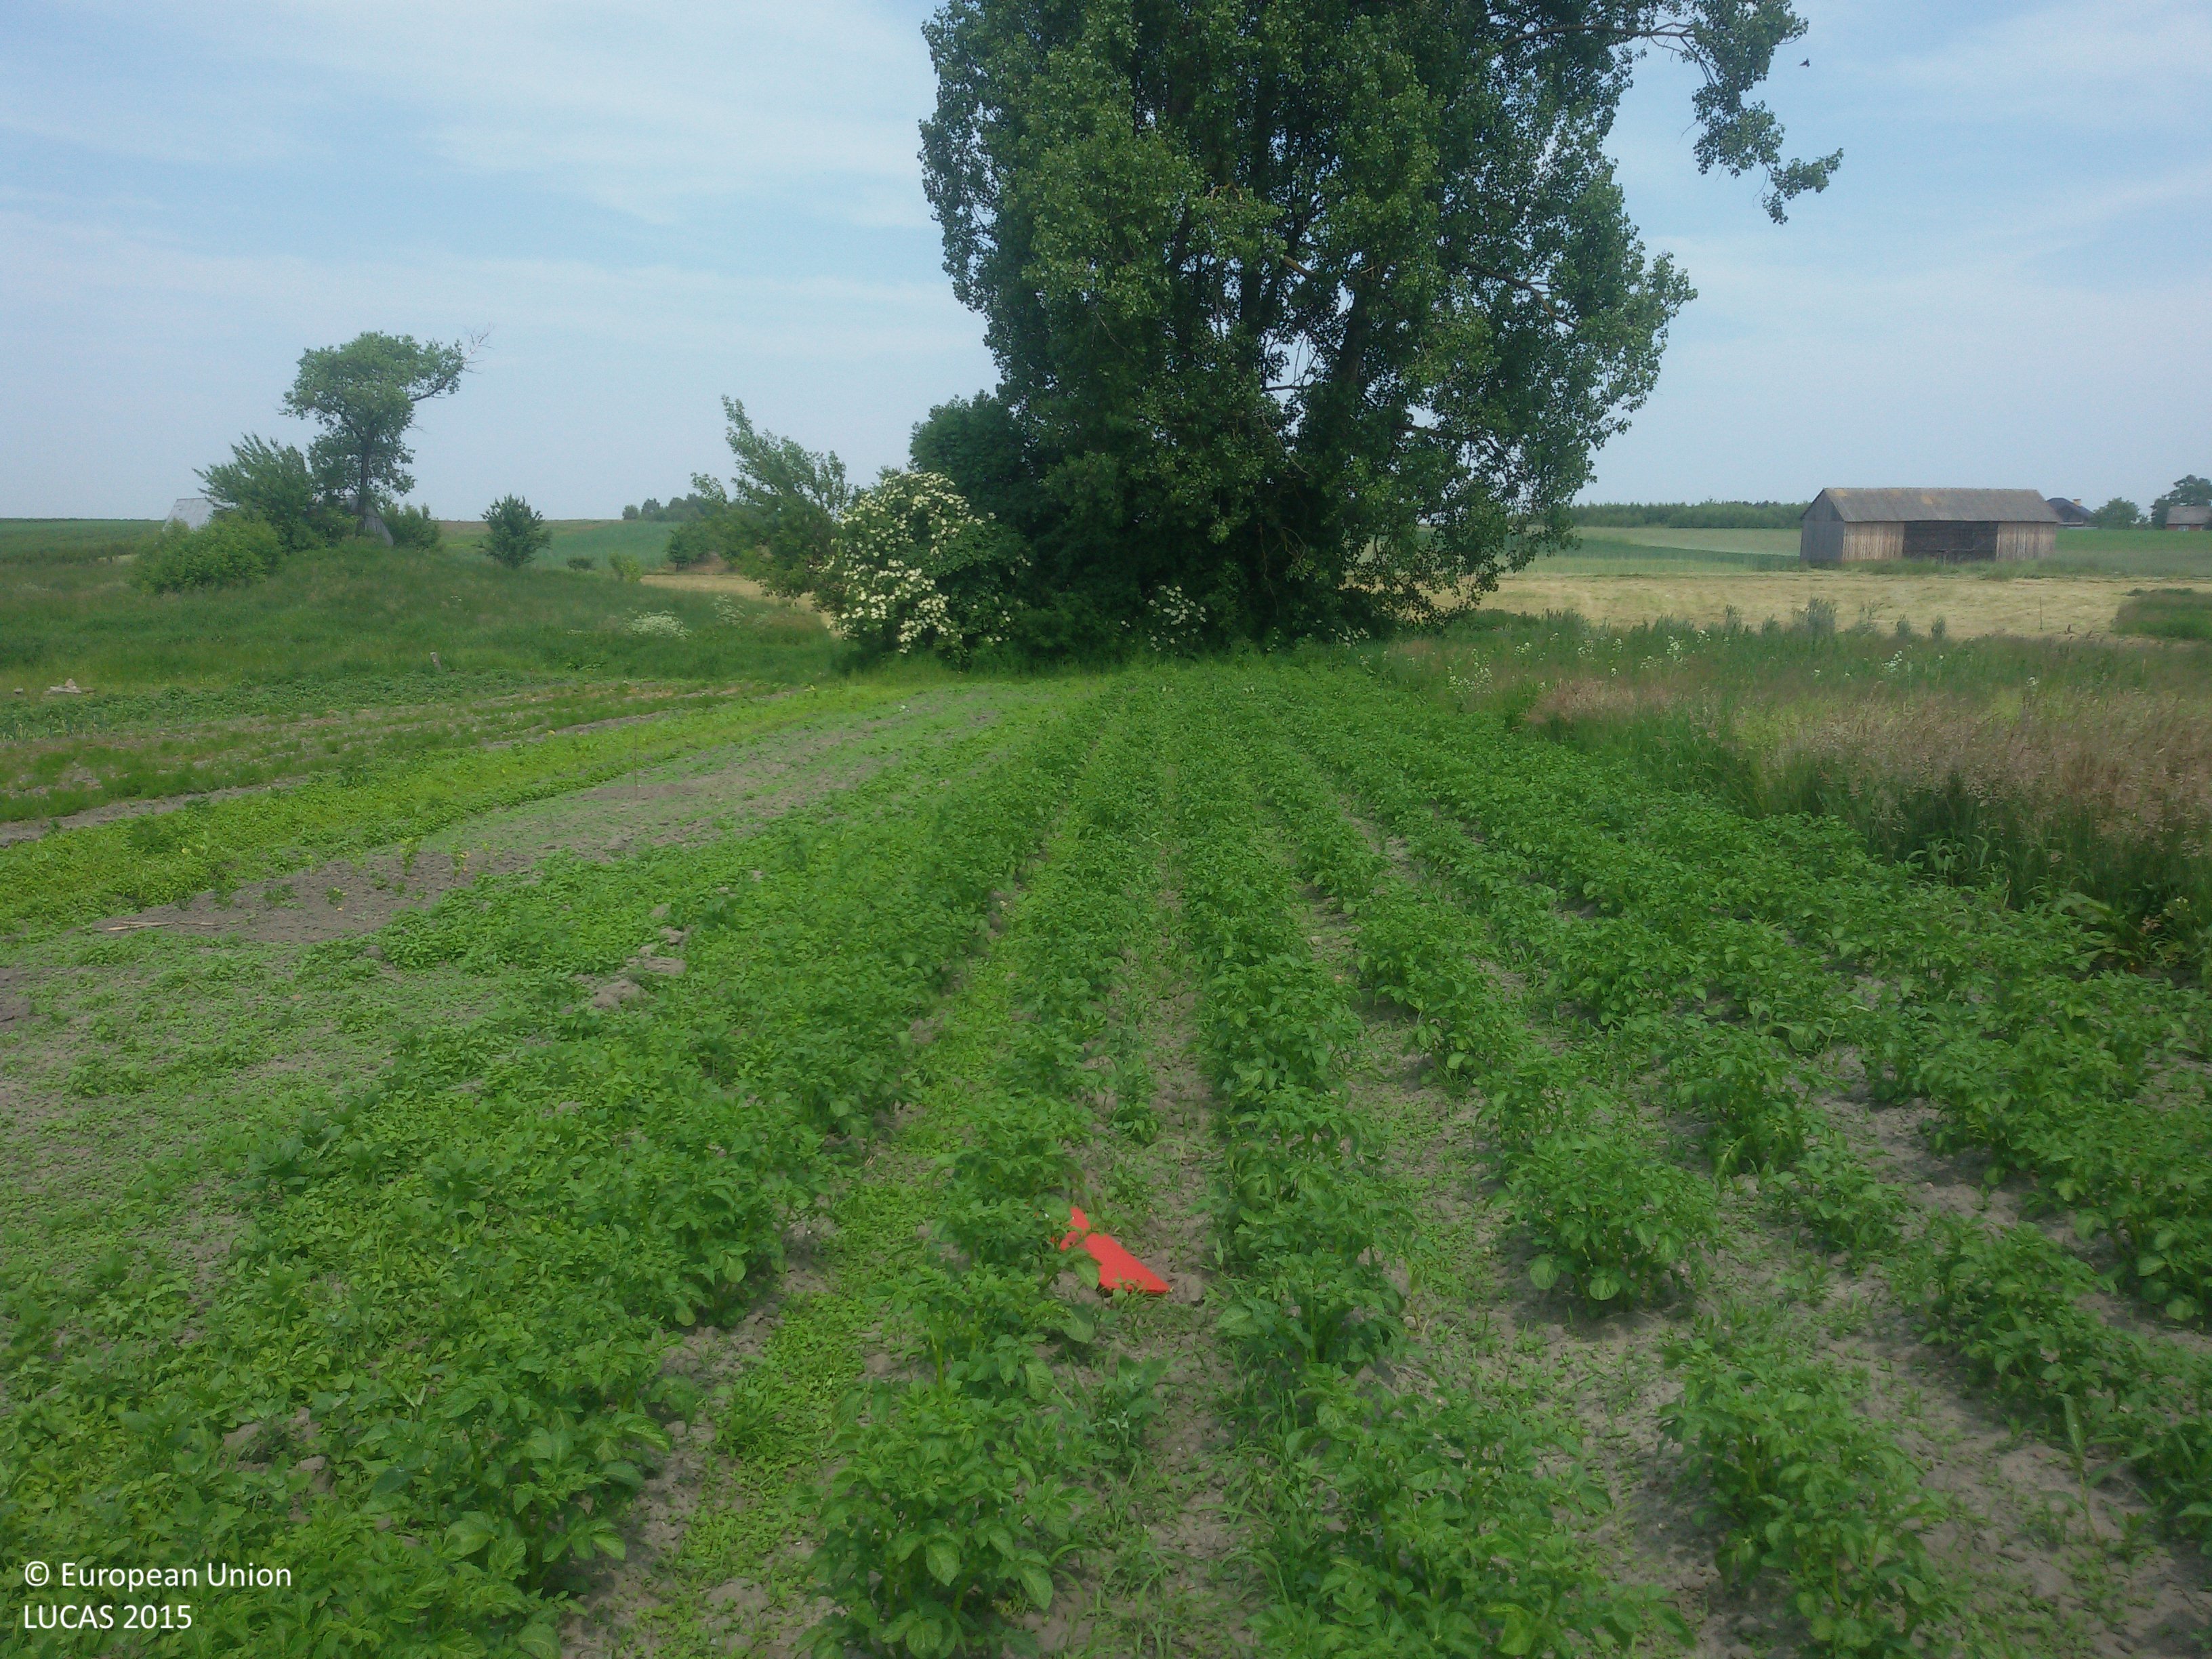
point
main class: Cropland
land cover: Potatoes
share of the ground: > 75 %
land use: Agriculture (excluding fallow land and kitchen gardens)
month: June
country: PL
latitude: 51.5354
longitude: 20.6363
